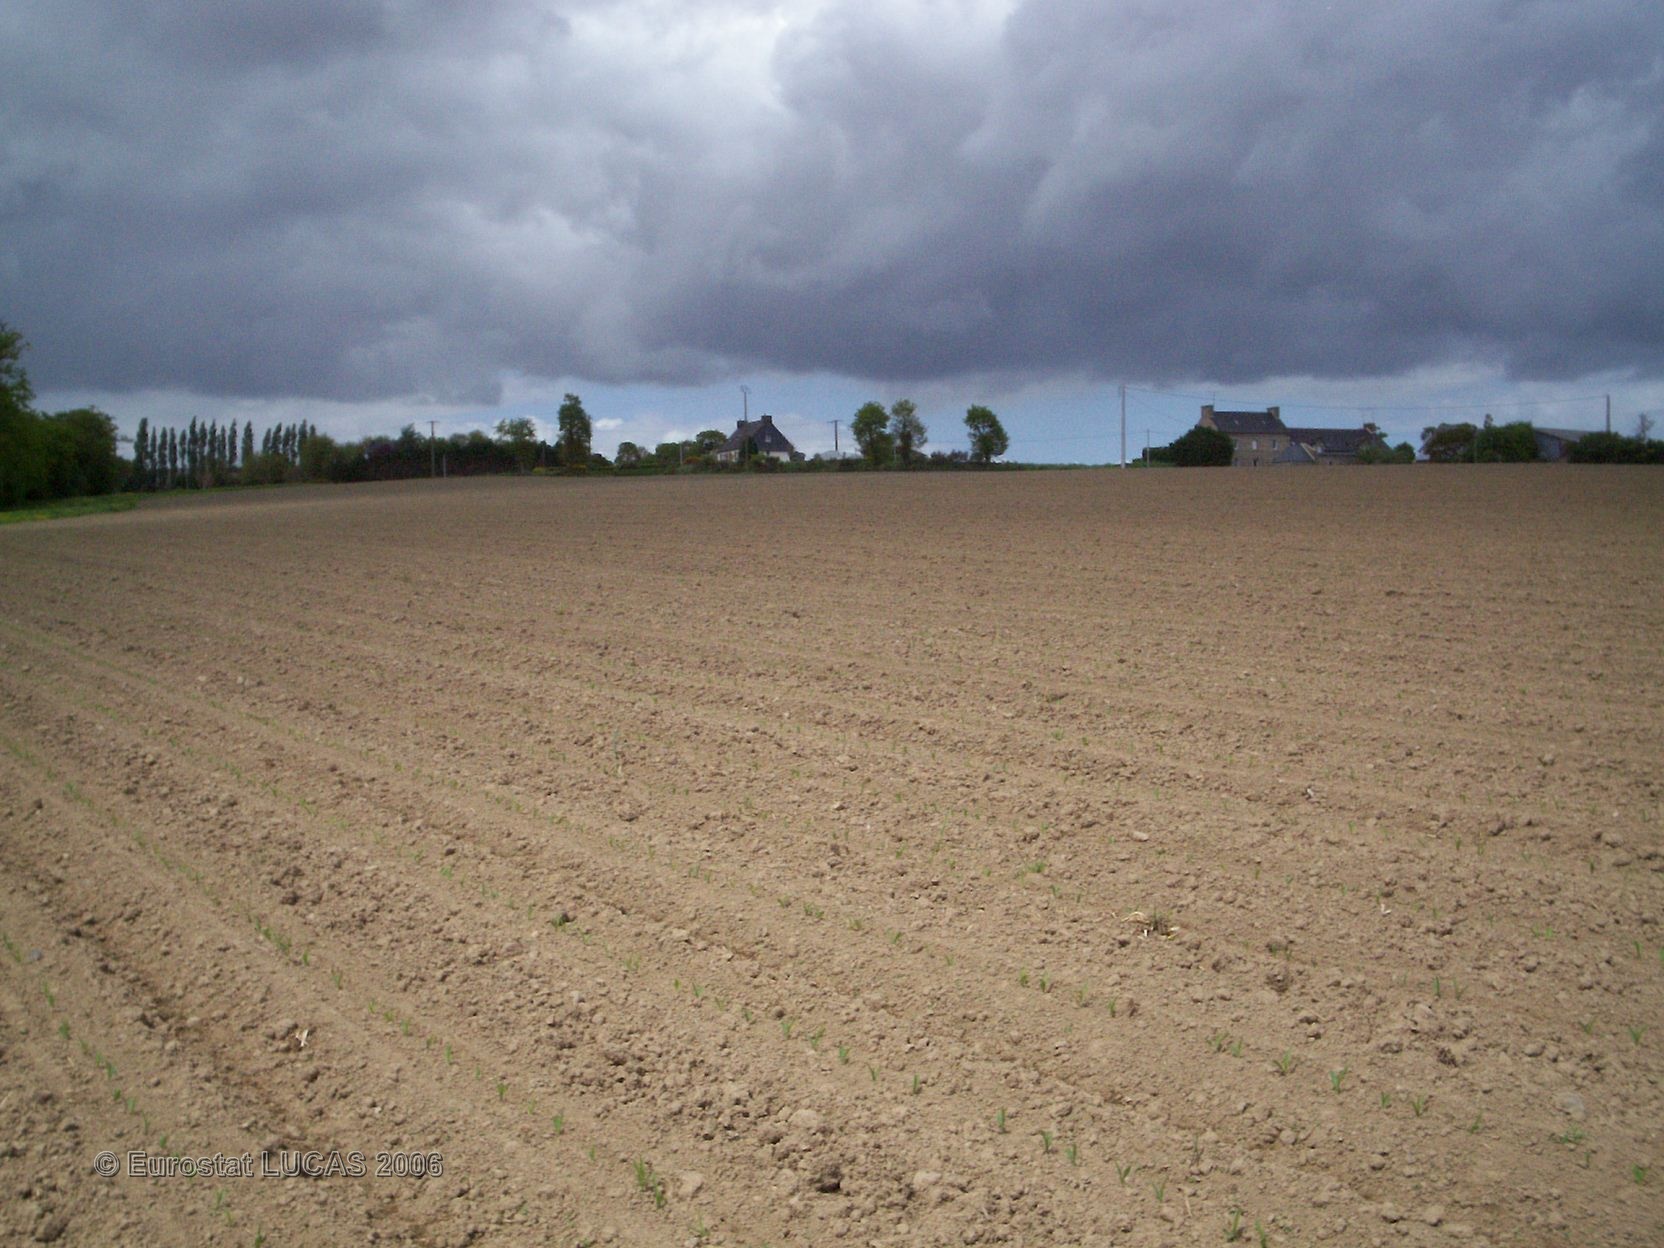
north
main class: Cropland
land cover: Maize
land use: Agriculture (excluding fallow land and kitchen gardens)
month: May
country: FR
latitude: 48.3783
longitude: -2.8528
